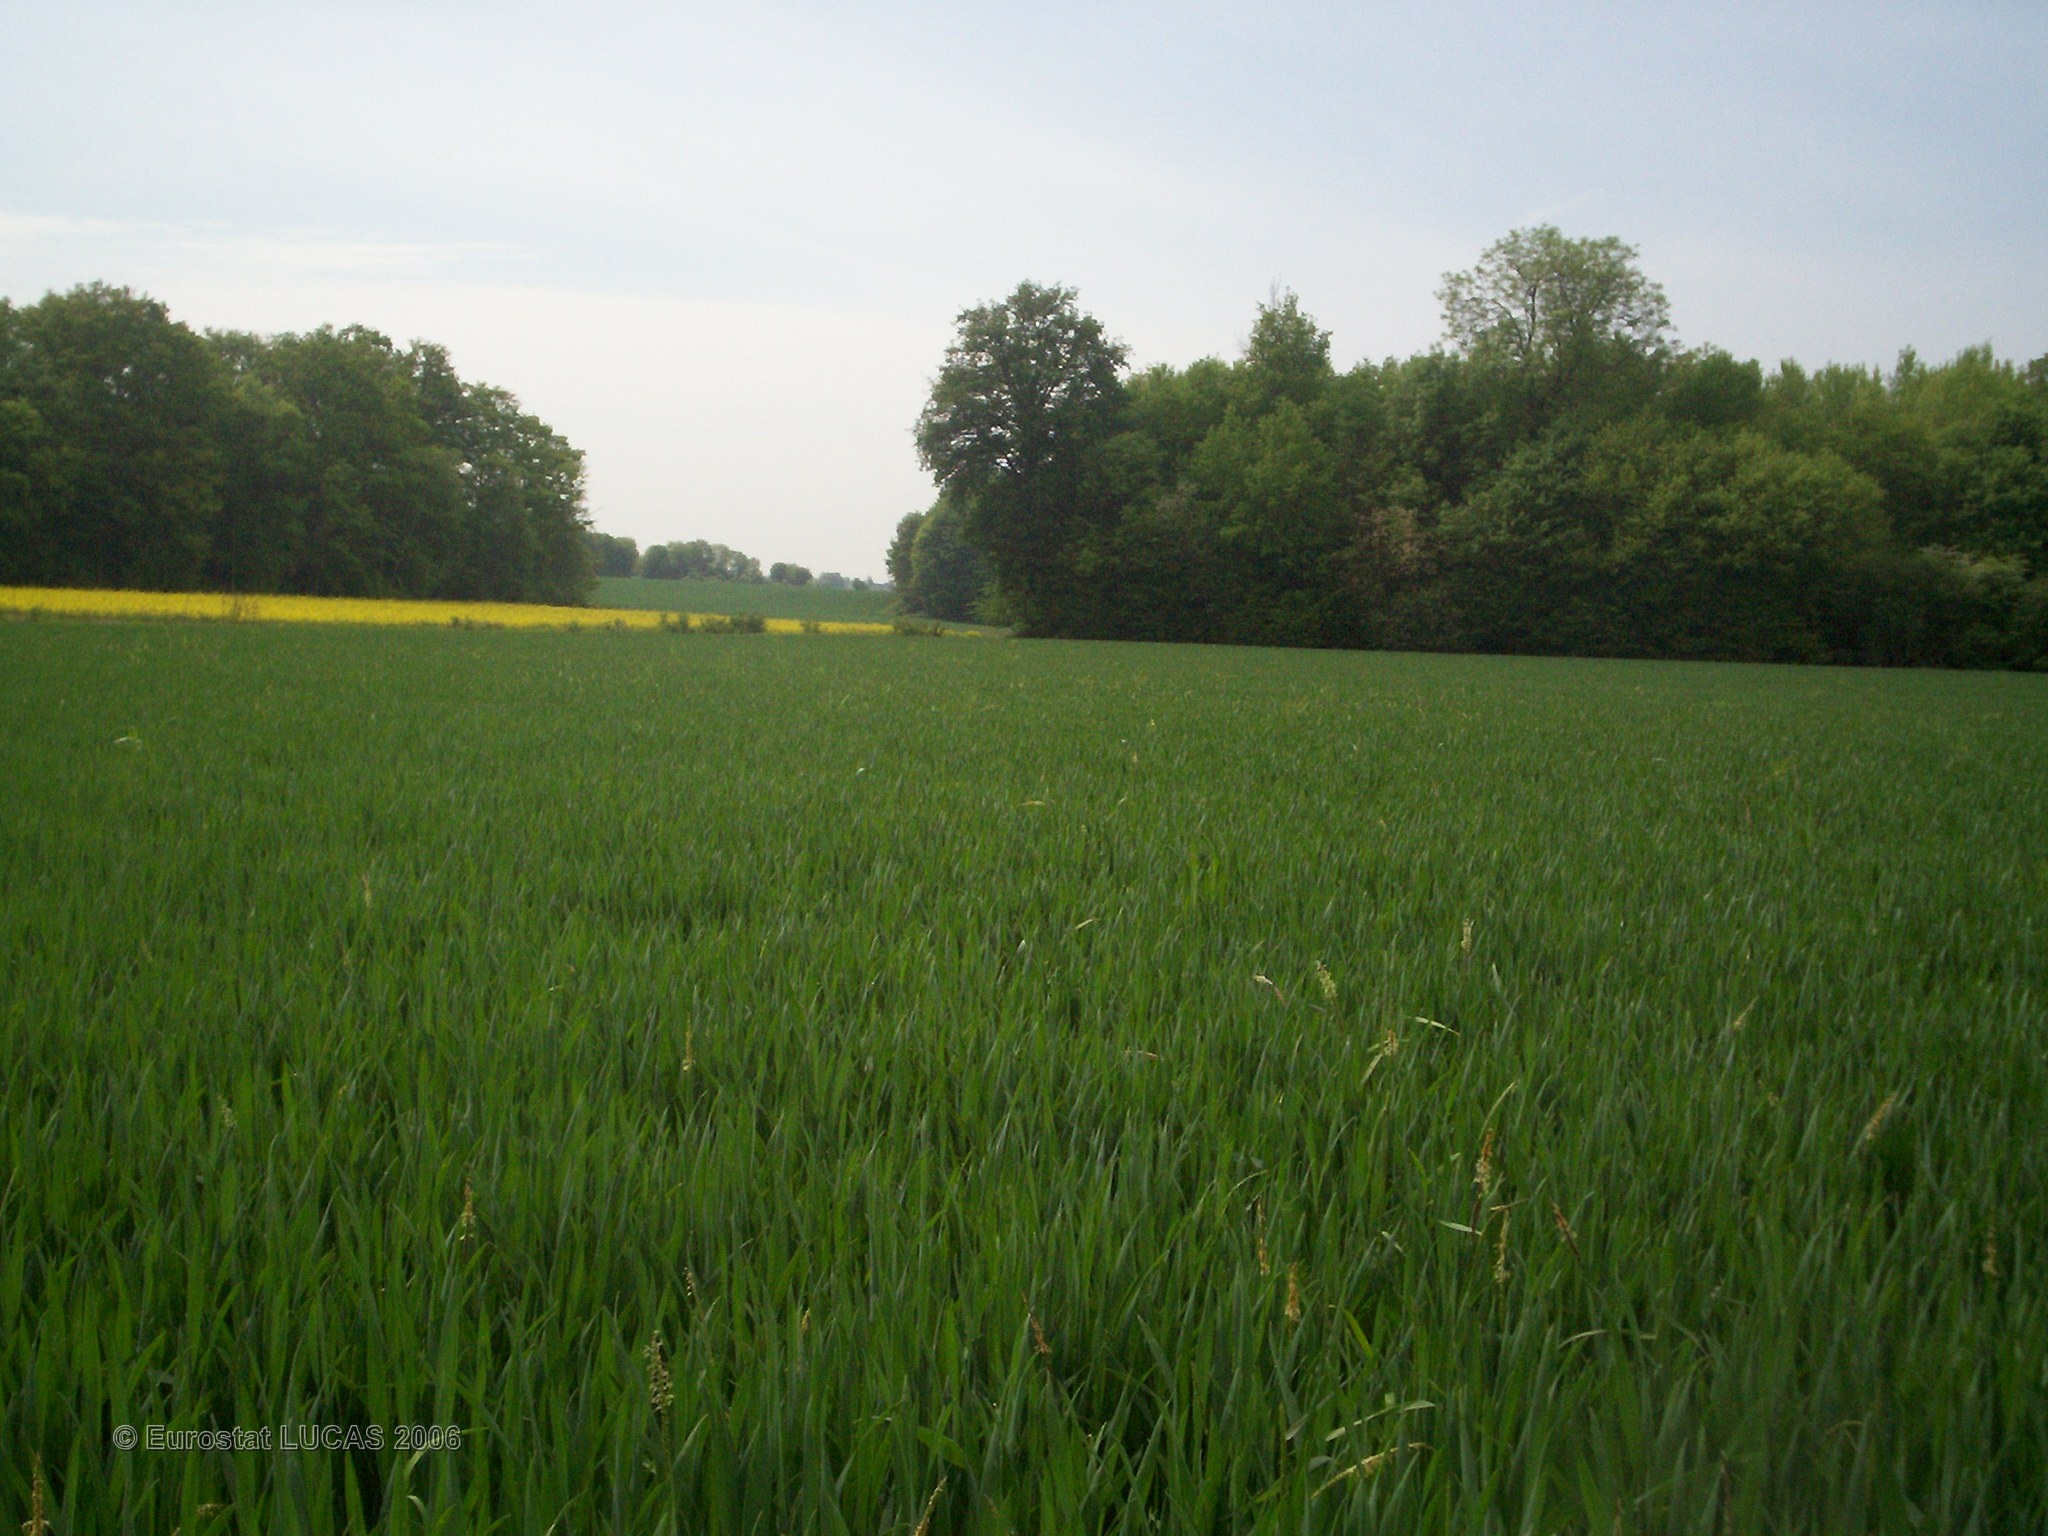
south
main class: Cropland
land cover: Common wheat
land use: Agriculture (excluding fallow land and kitchen gardens)
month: May
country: FR
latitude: 47.7637
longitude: 2.9622
